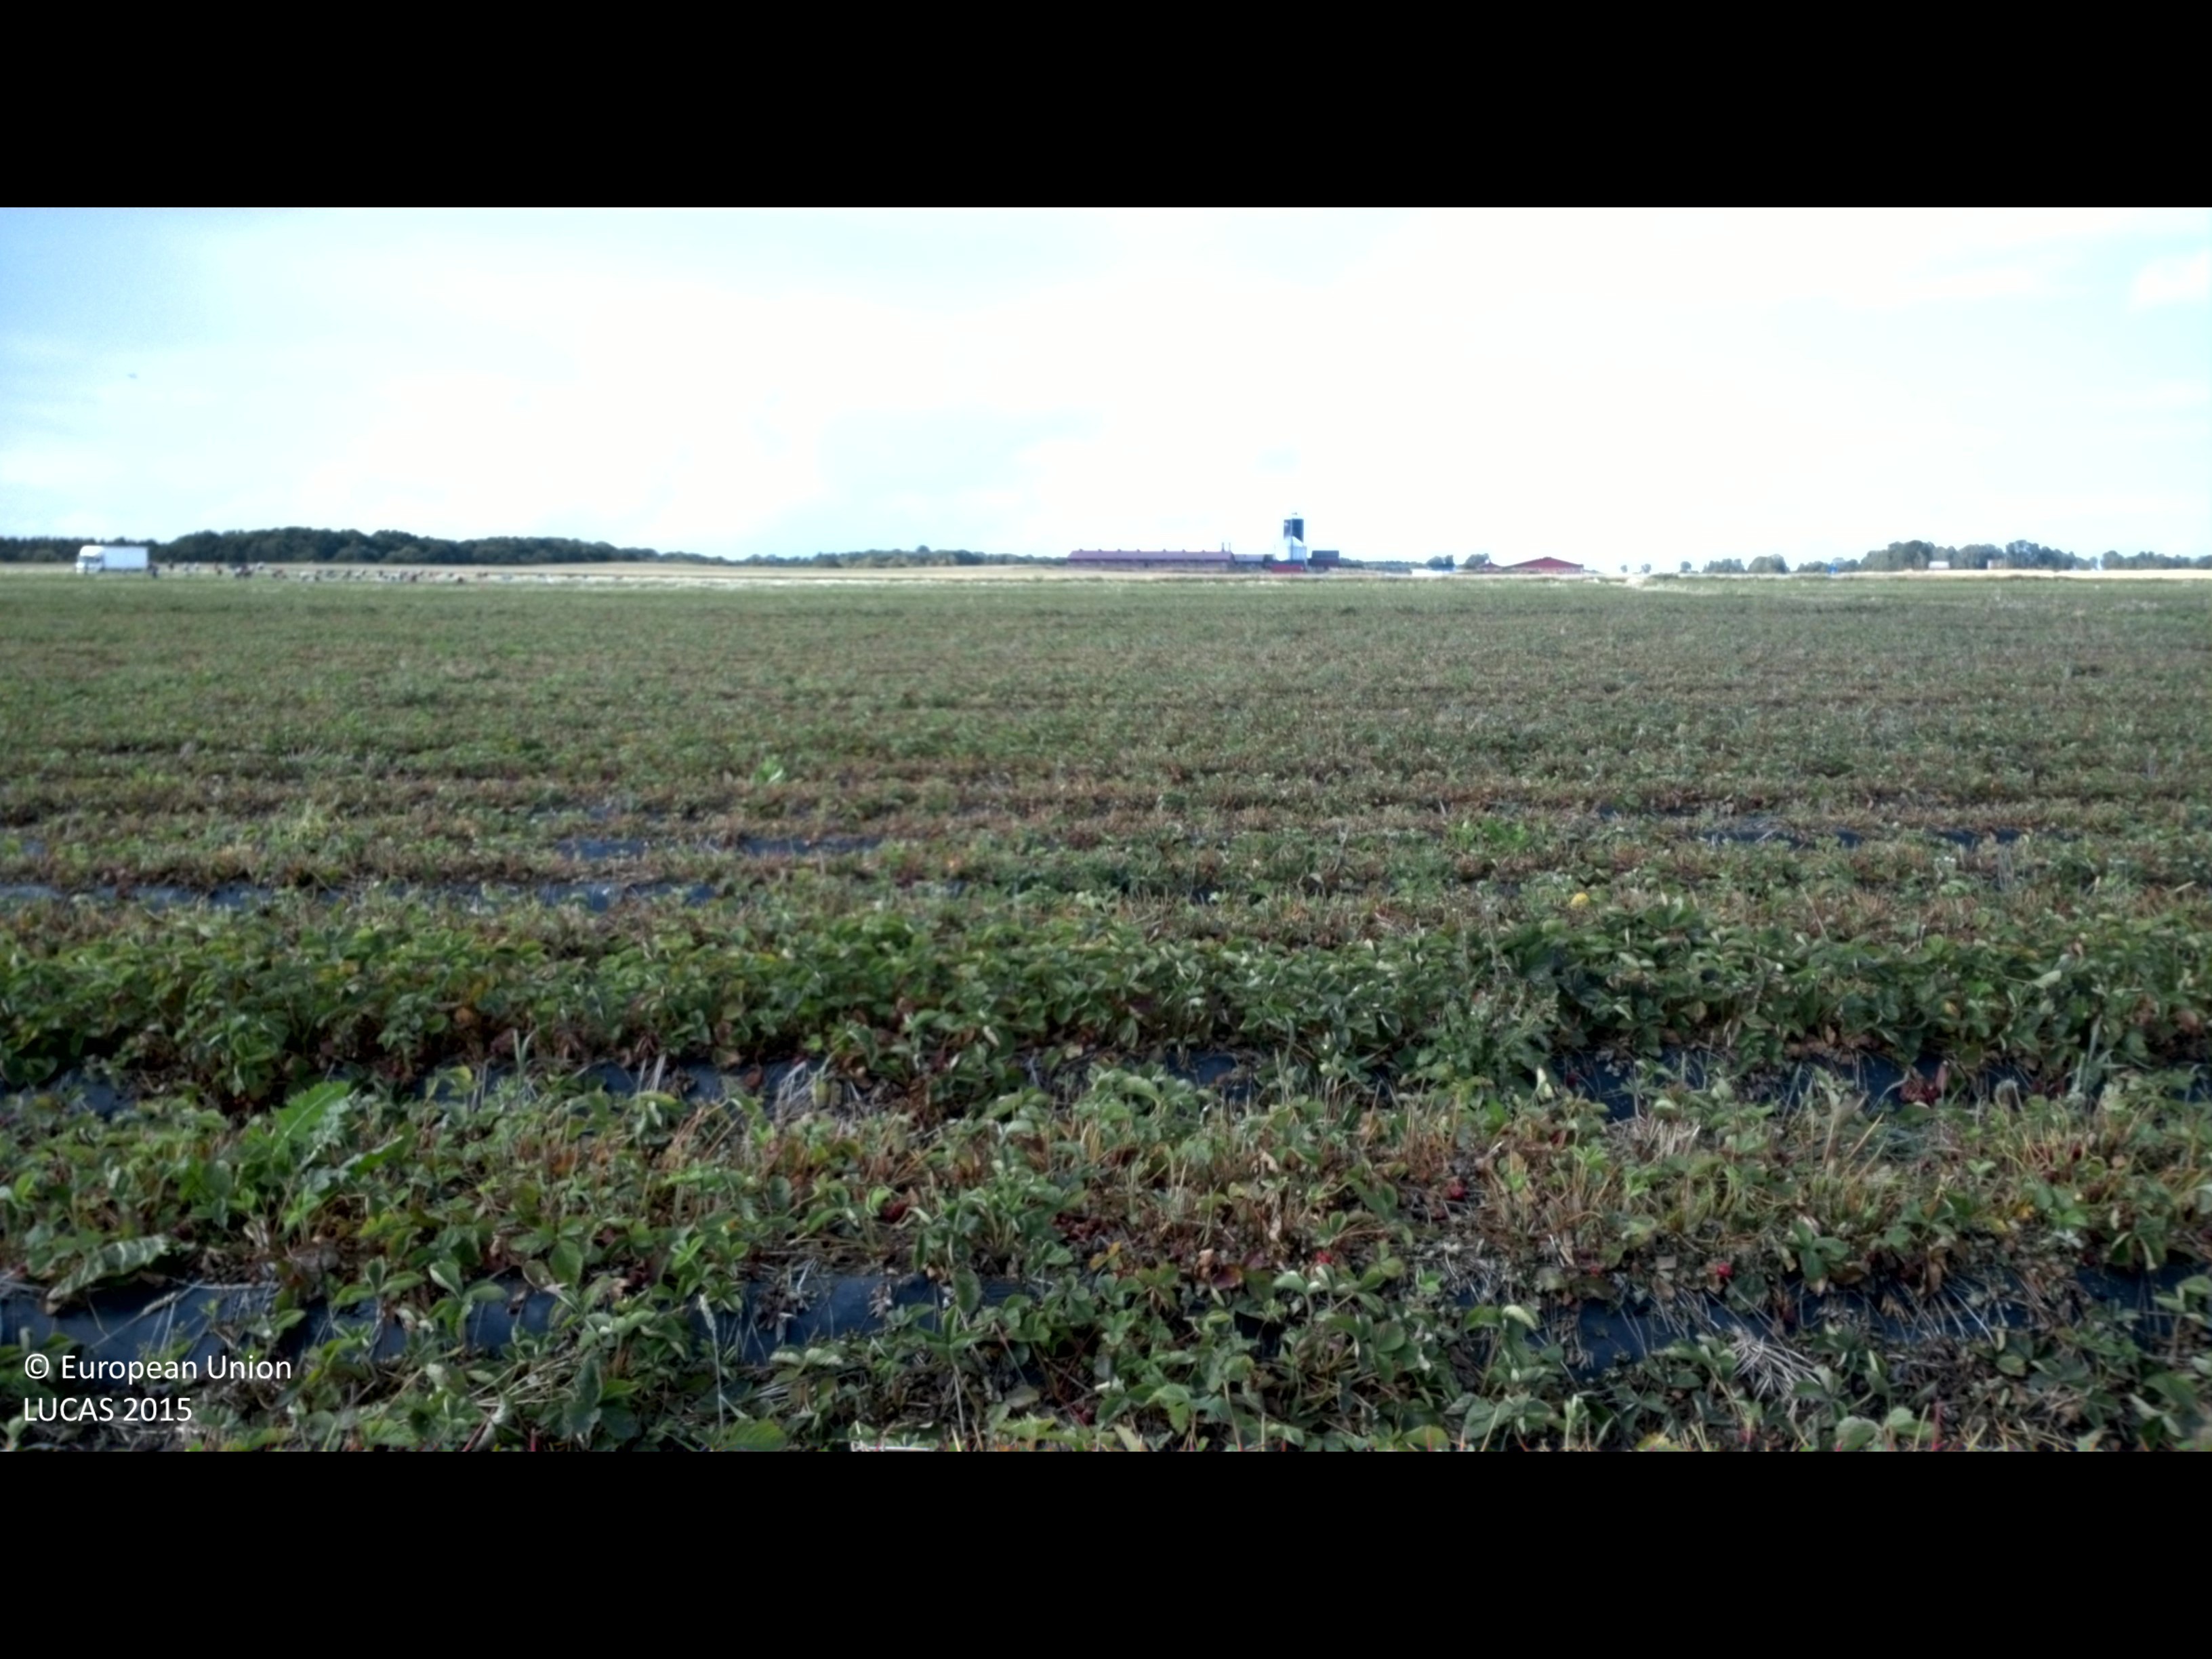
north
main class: Cropland
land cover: Strawberries
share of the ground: > 75 %
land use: Agriculture (excluding fallow land and kitchen gardens)
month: July
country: SE
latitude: 56.5678
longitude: 16.4298
